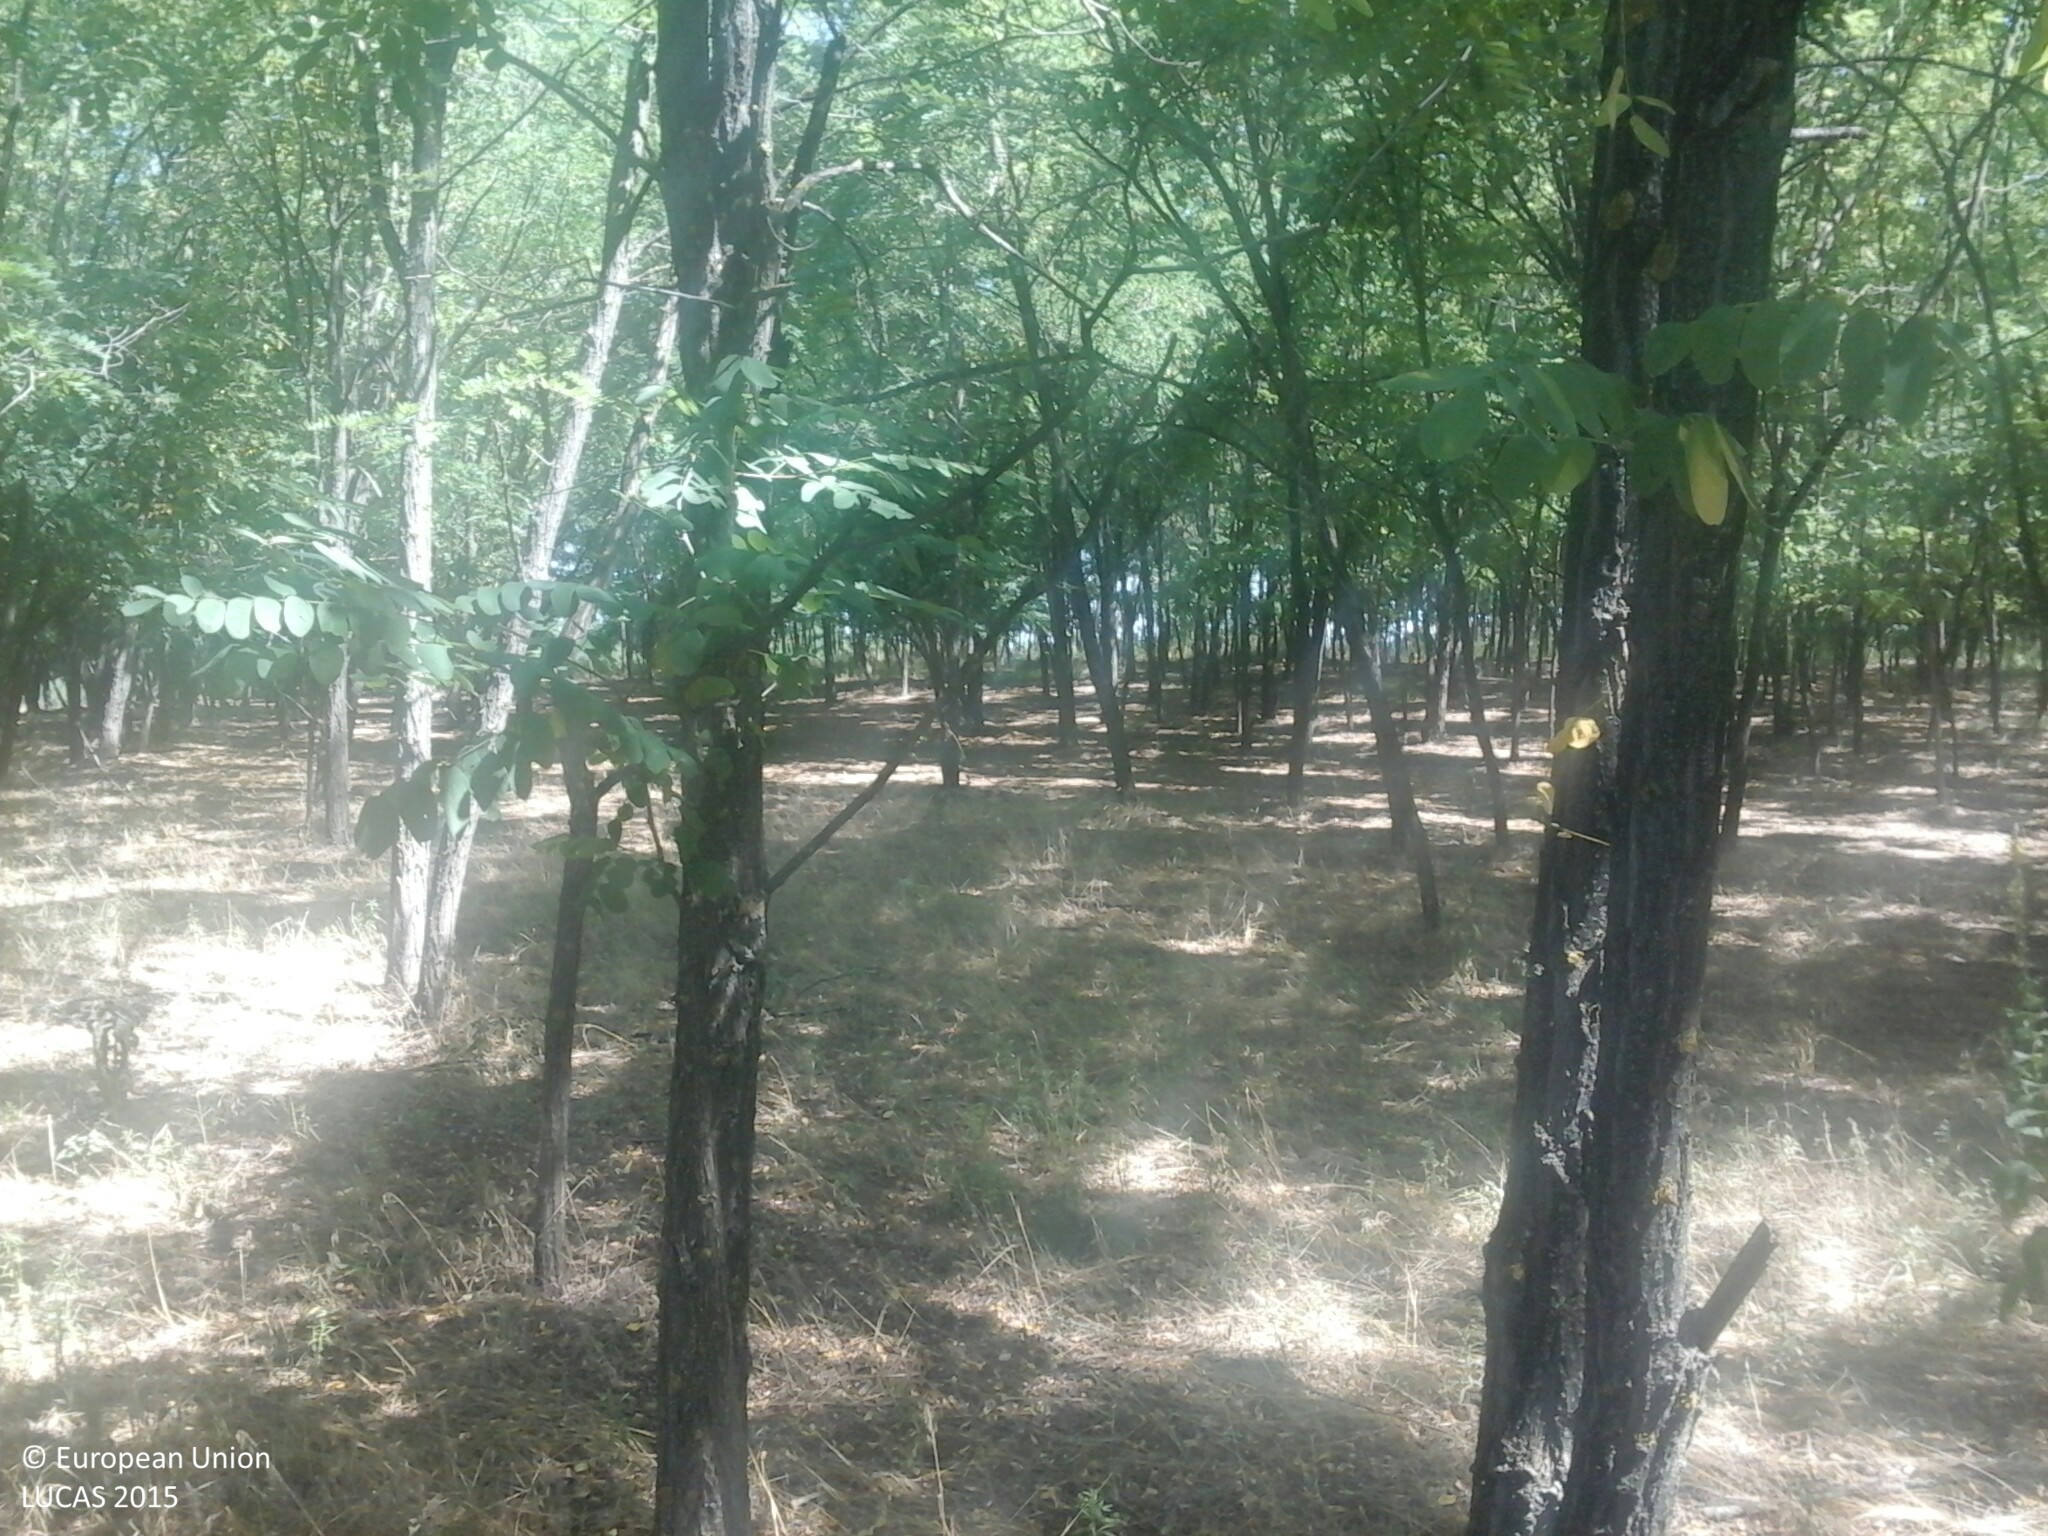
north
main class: Woodland
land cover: Broadleaved woodland
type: exotic forest
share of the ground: > 75 %
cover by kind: broadleaved forest trees 95 %, herbaceous plants 5 %
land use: Forestry
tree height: > 5 m
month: July
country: HU
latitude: 48.0409
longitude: 22.3029
